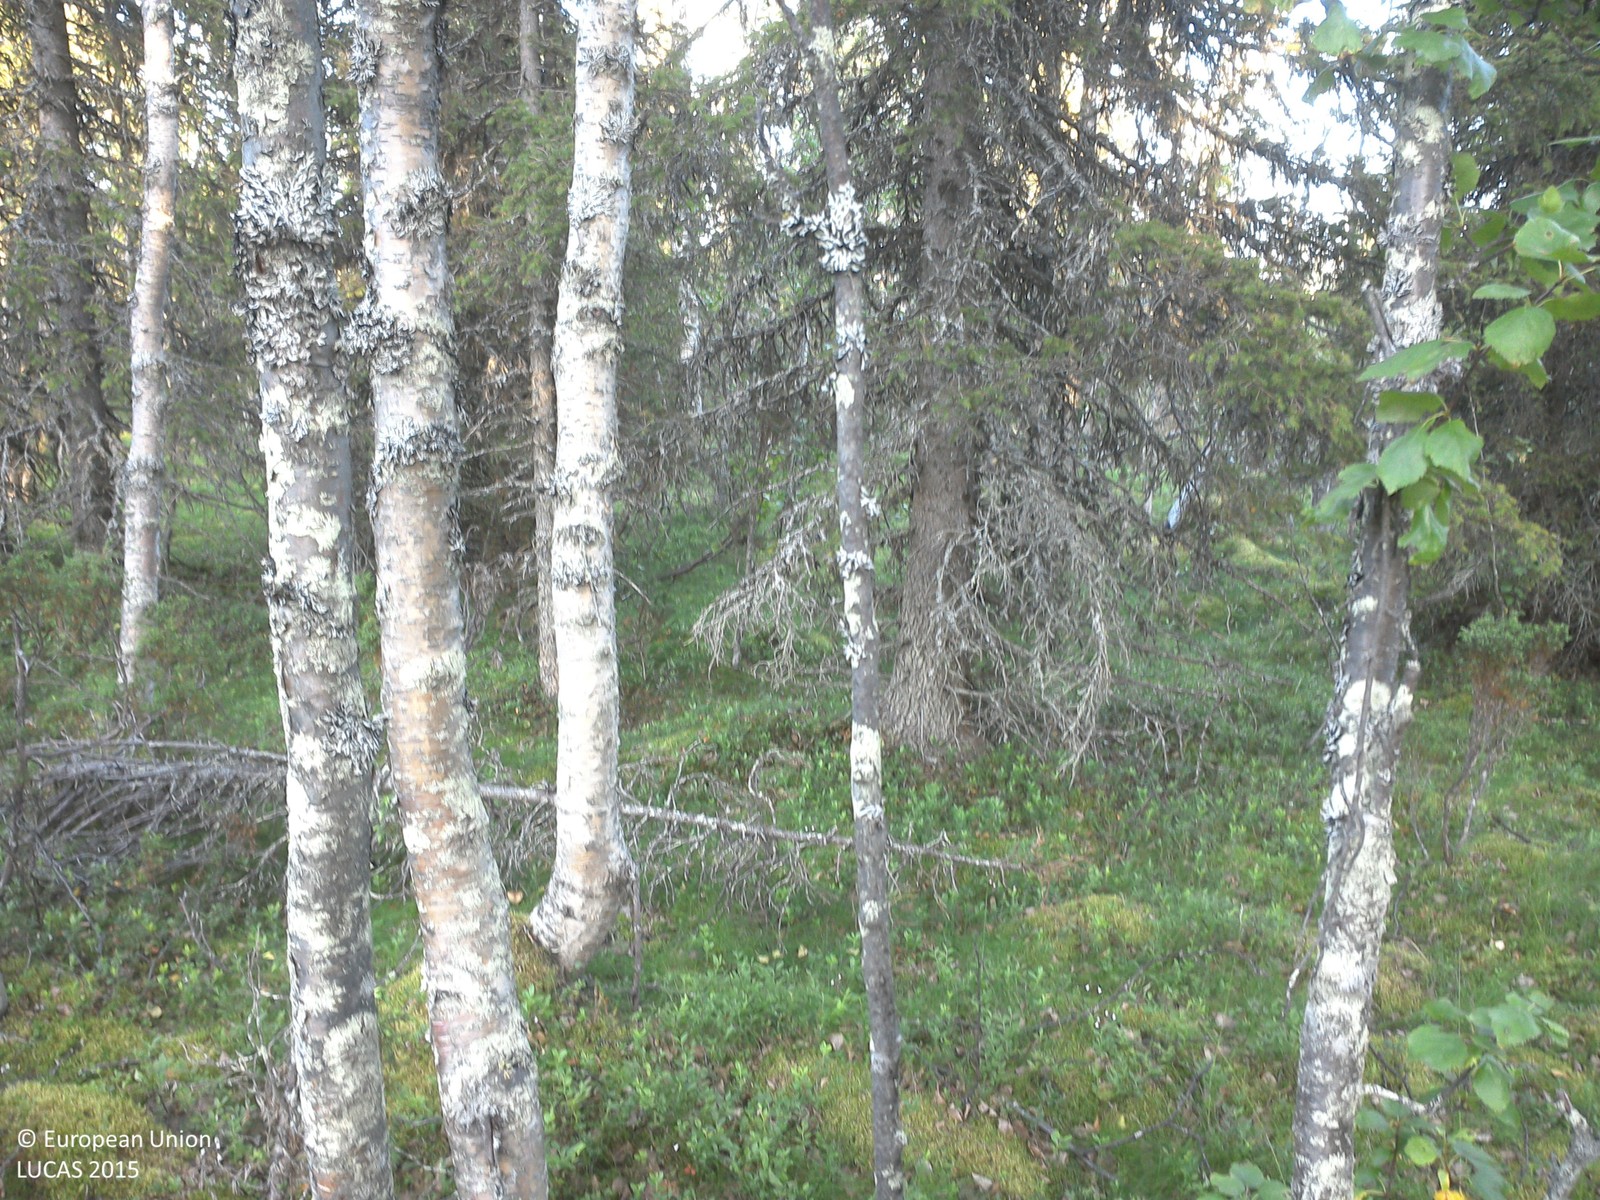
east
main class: Woodland
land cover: Spruce dominated mixed woodland
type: boreal forest
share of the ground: 25 - 50 %
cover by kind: shrubs 40 %, coniferous forest trees 20 %, lichens and mosses 20 %, broadleaved forest trees 15 %, herbaceous plants 5 %
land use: Forestry
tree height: > 5 m
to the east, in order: Spruce dominated mixed woodland
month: August
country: SE
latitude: 67.3009
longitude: 21.1196
